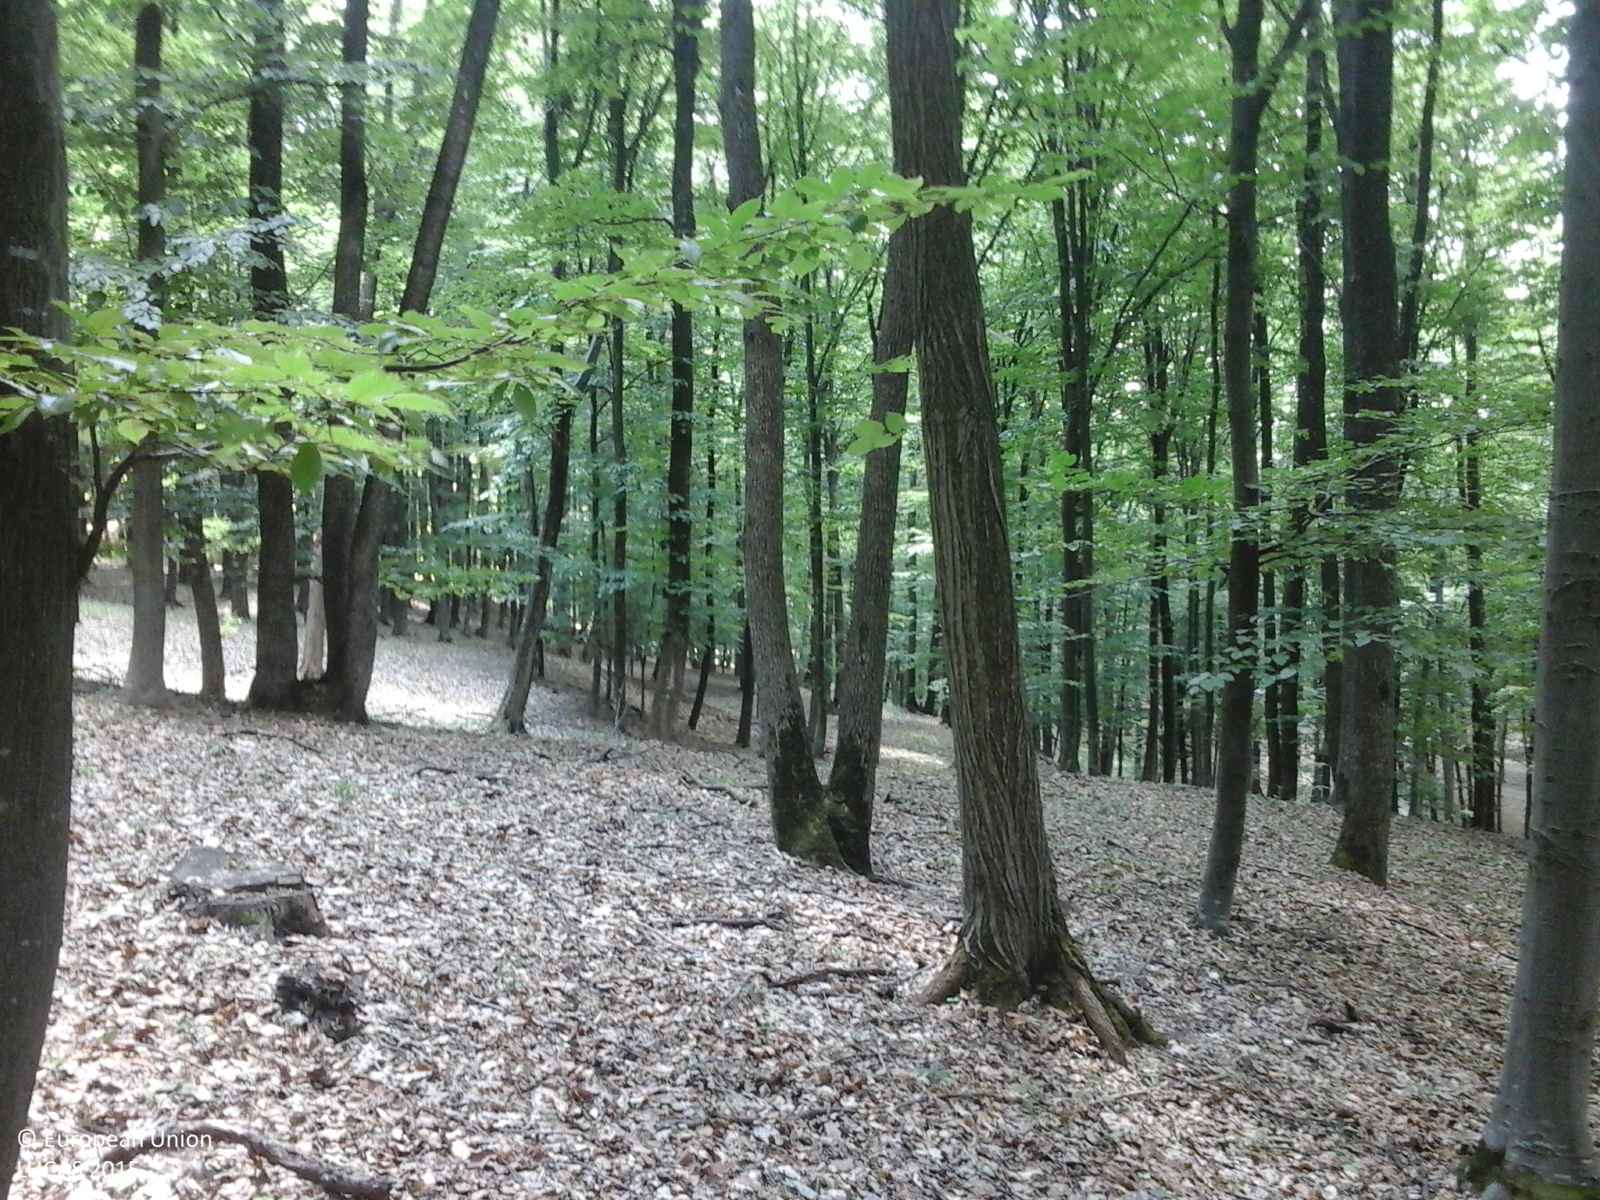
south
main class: Woodland
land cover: Broadleaved woodland
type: mesophytic deciduous forest
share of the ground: > 75 %
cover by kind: broadleaved forest trees 100 %
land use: Forestry
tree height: > 5 m
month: June
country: RO
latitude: 46.4057
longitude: 27.1528
